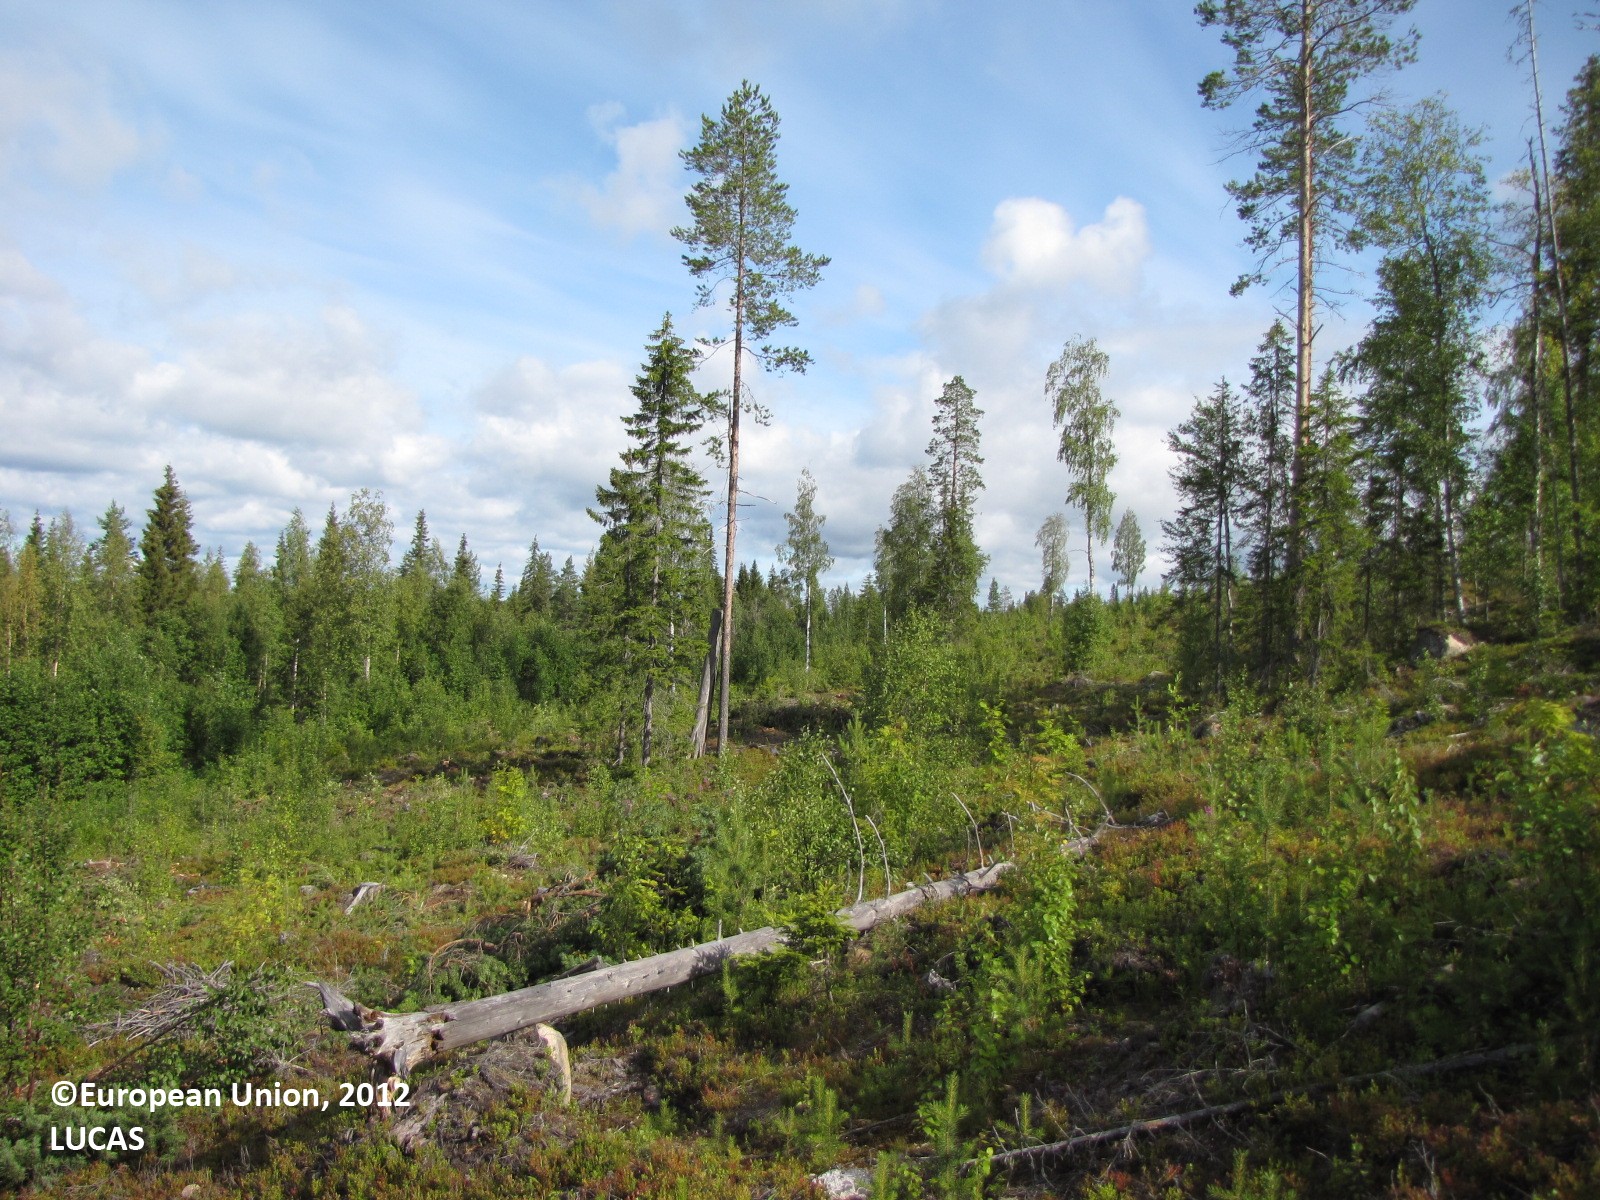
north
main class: Woodland
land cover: Pine dominated mixed woodland
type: boreal forest
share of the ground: 10 - 25 %
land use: Forestry
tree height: < 5 m
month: August
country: FI
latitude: 66.8699
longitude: 24.6655
